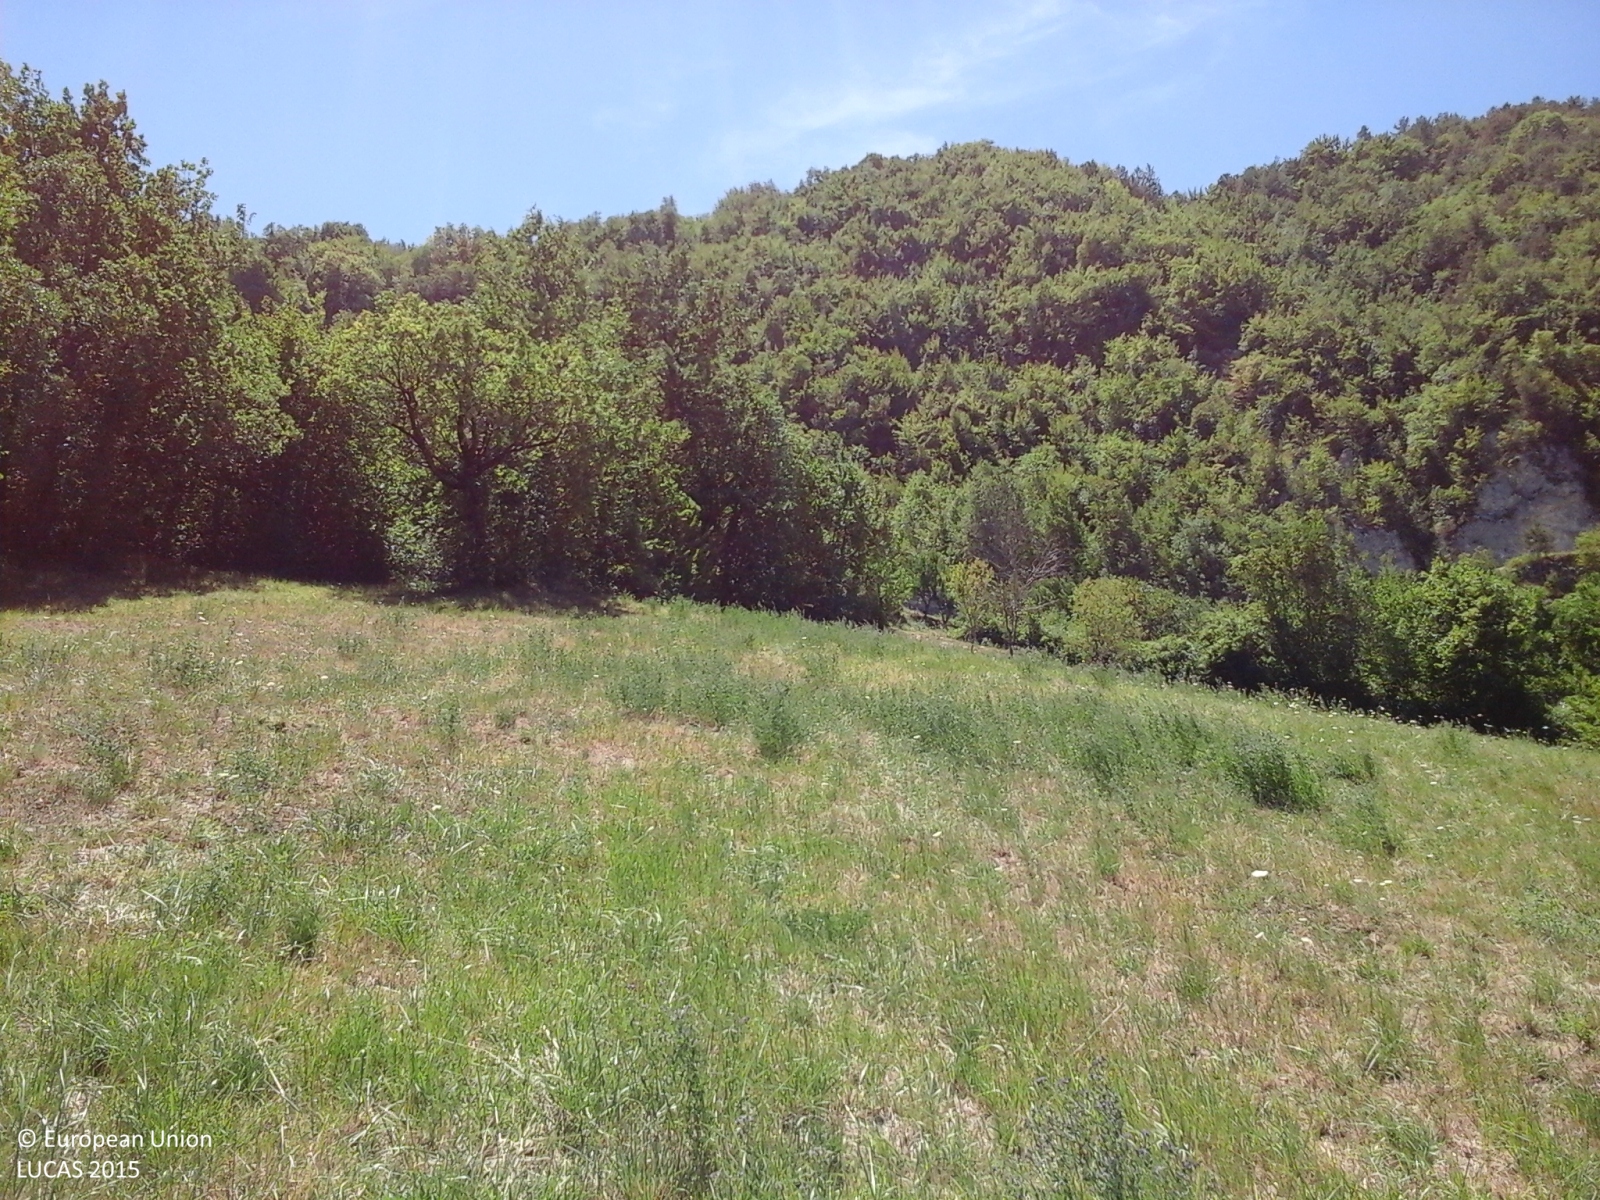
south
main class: Grassland
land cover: Grassland without tree/shrub cover
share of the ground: > 75 %
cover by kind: herbaceous plants 100 %
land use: Agriculture (excluding fallow land and kitchen gardens)
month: July
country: IT
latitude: 41.4928
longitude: 14.3562
